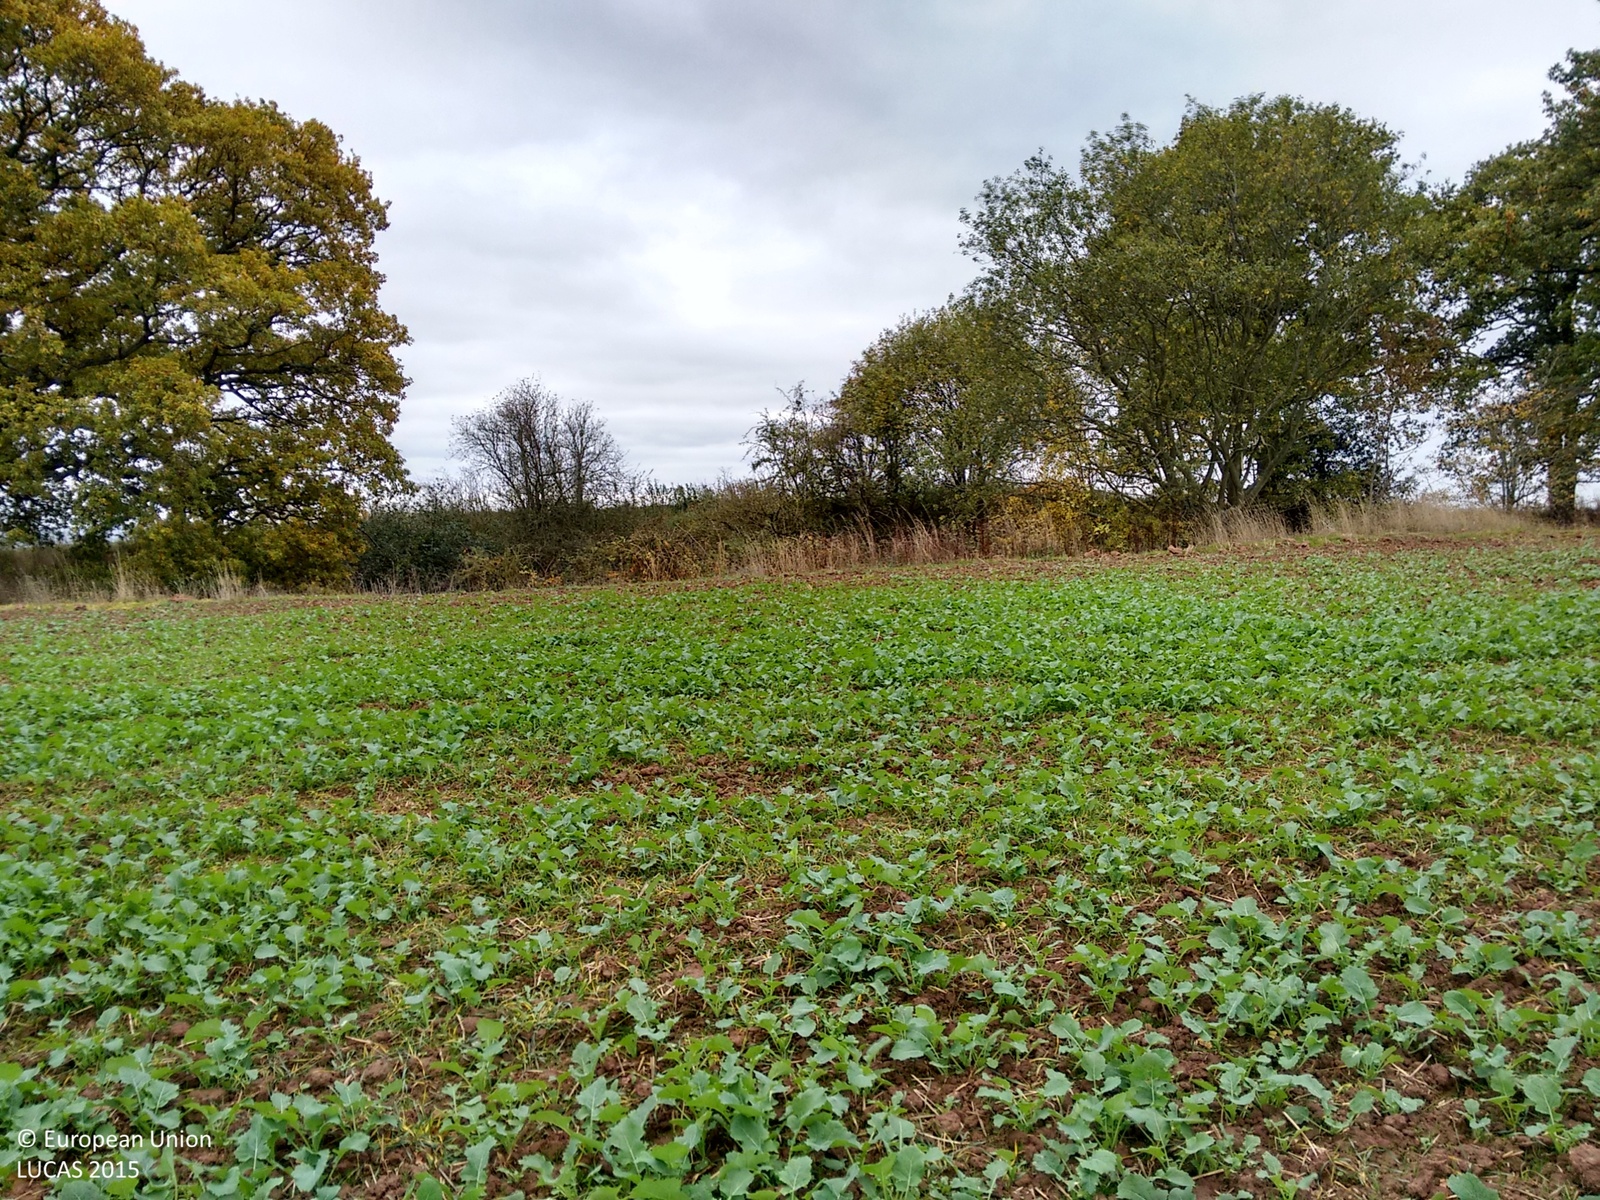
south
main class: Cropland
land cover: Rape and turnip rape
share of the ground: > 75 %
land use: Agriculture (excluding fallow land and kitchen gardens)
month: October
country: GB
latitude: 51.9839
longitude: -2.6937
